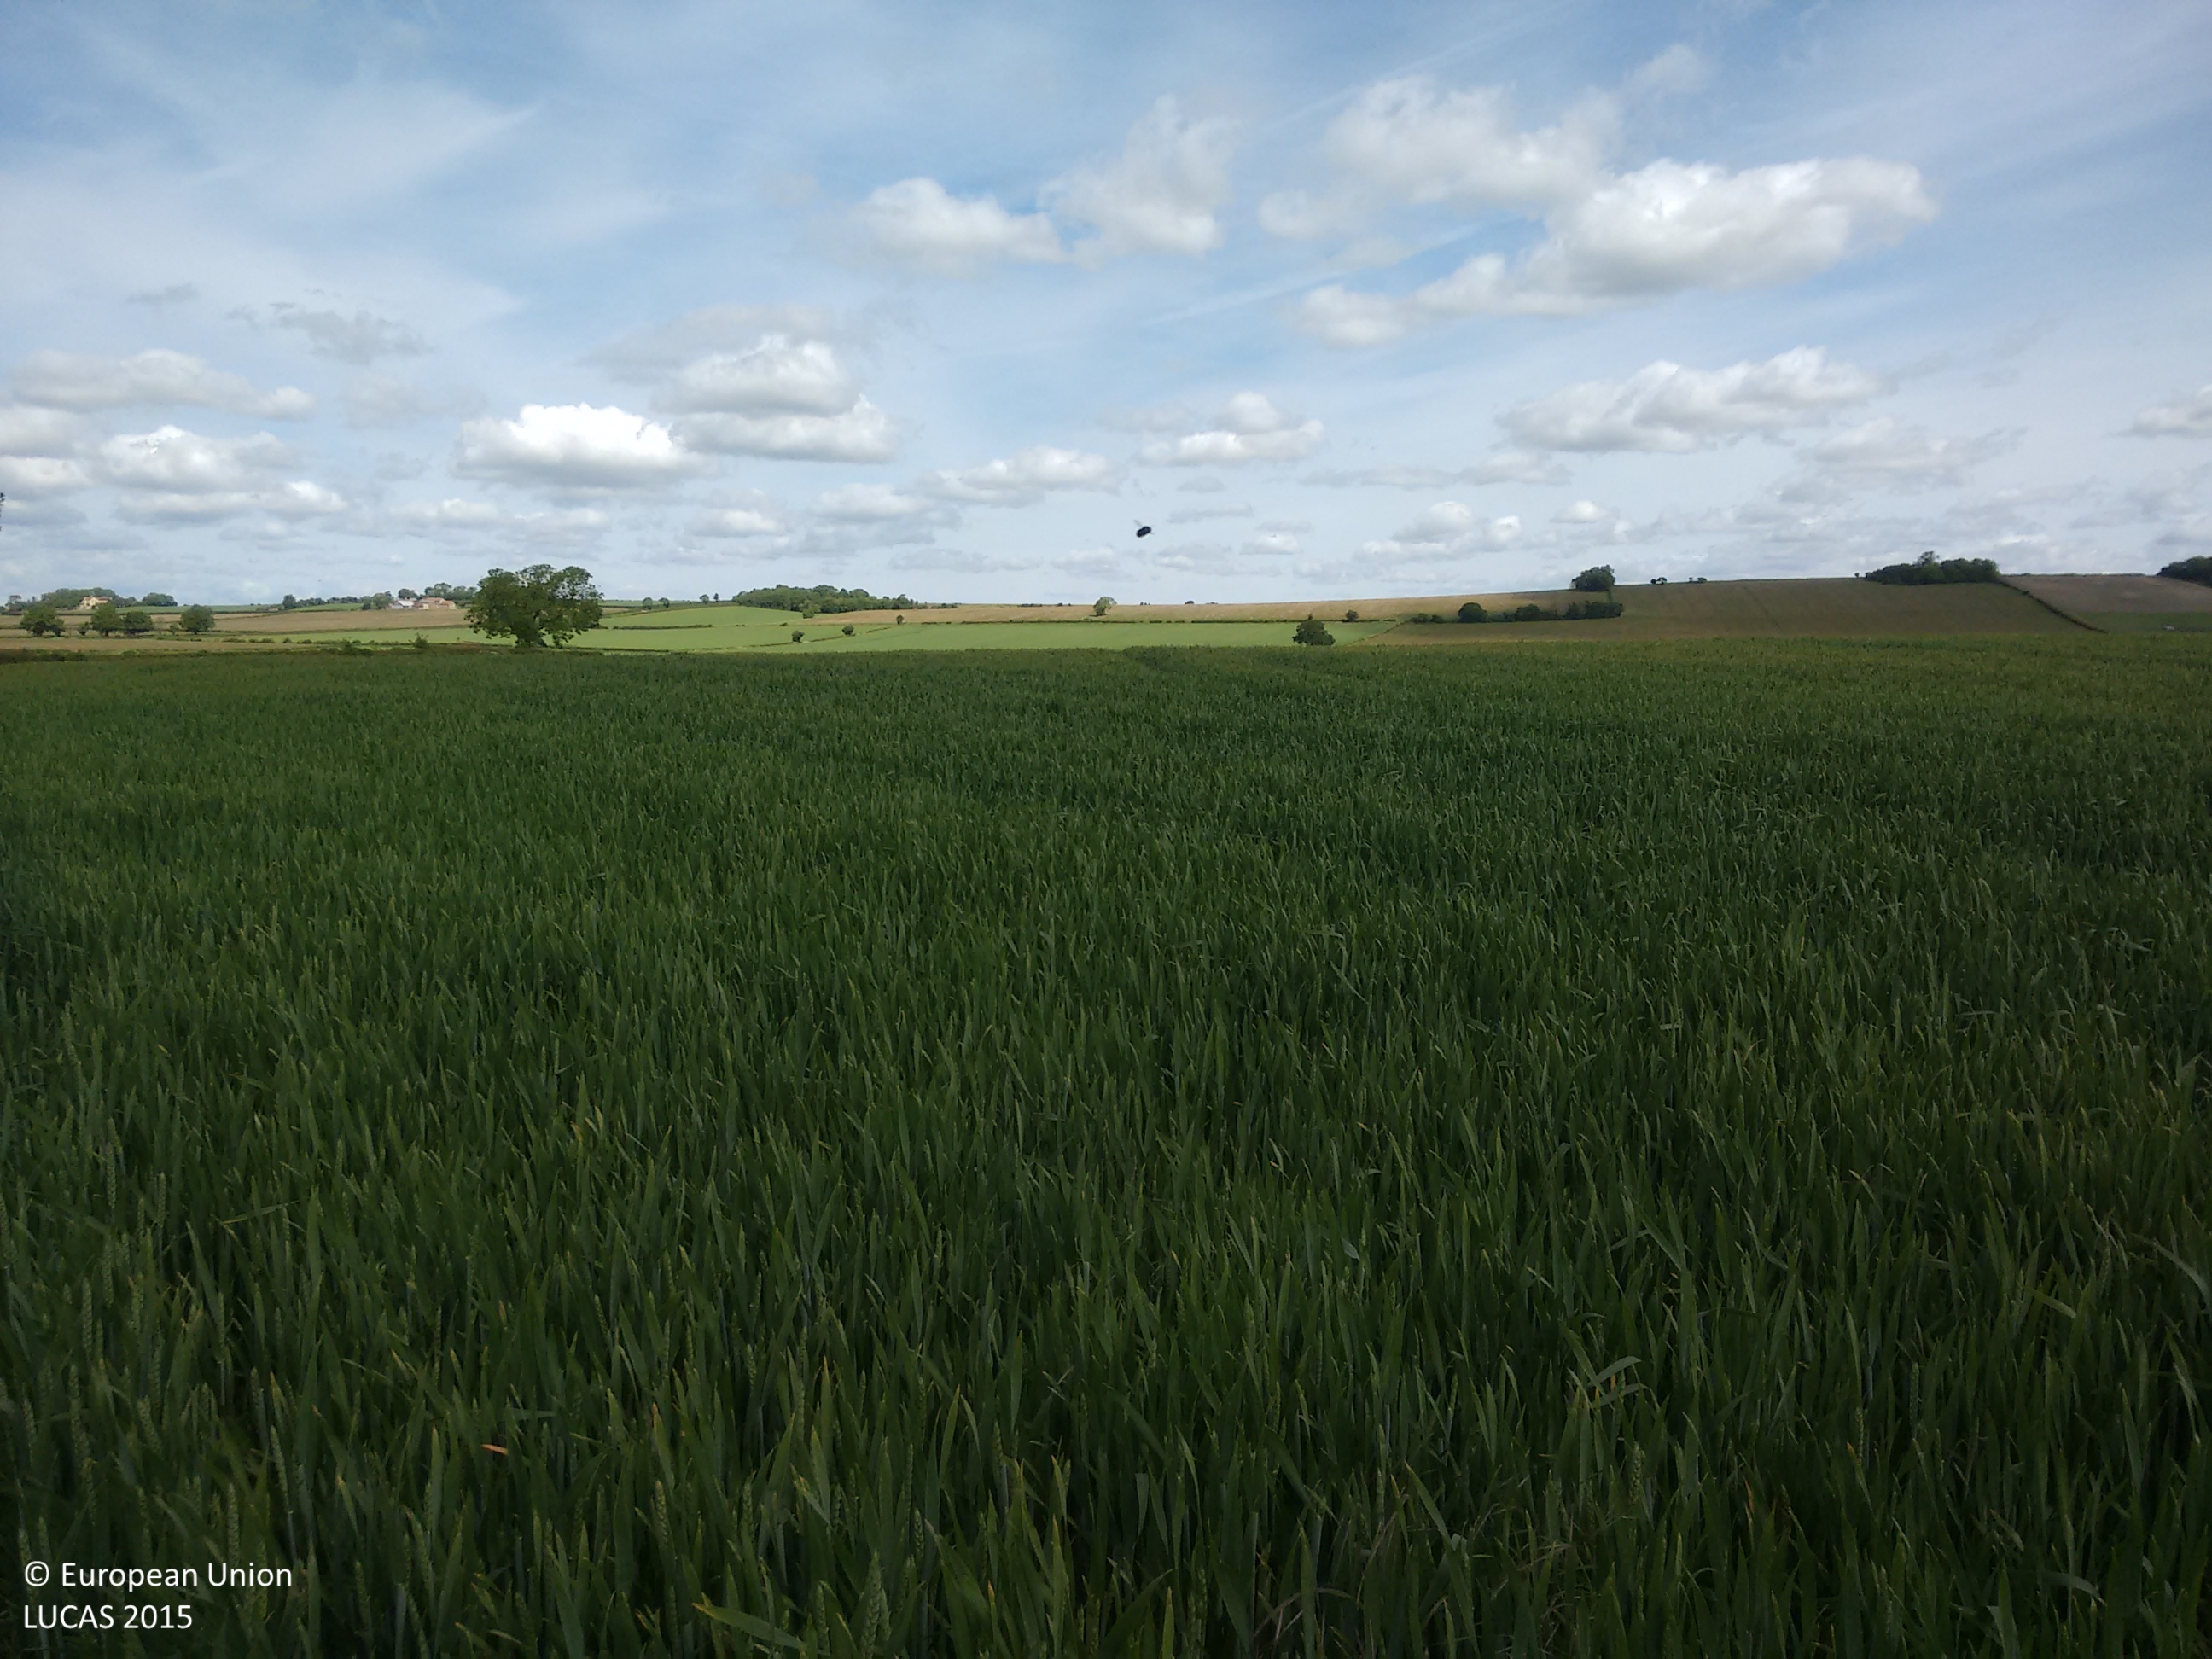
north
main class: Cropland
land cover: Common wheat
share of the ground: > 75 %
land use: Agriculture (excluding fallow land and kitchen gardens)
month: June
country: GB
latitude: 54.0978
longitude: -0.7898
